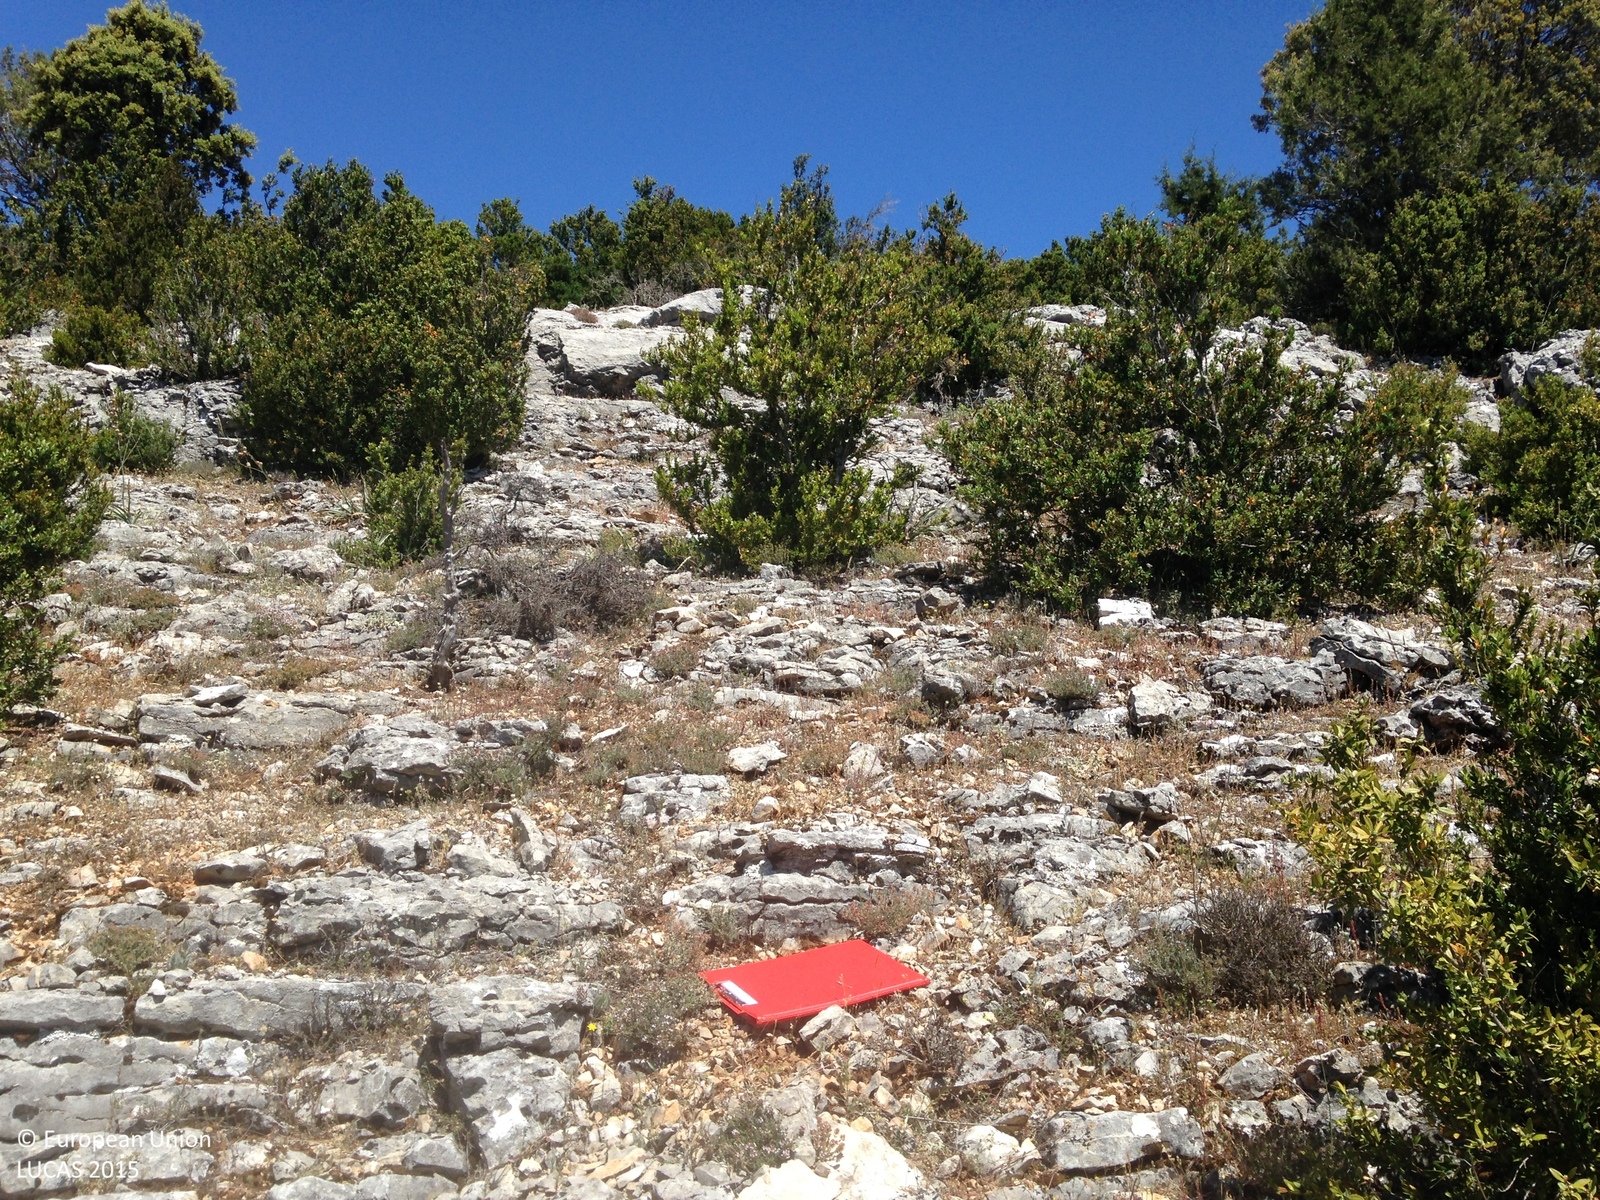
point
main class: Shrubland
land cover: Shrubland without tree cover
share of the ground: 10 - 25 %
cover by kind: shrubs 45 %, consolidated bare surface 35 %, herbaceous plants 20 %
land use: Semi-natural and natural areas not in use
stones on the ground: > 50 %
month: May
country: ES
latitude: 40.4909
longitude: -2.0421
